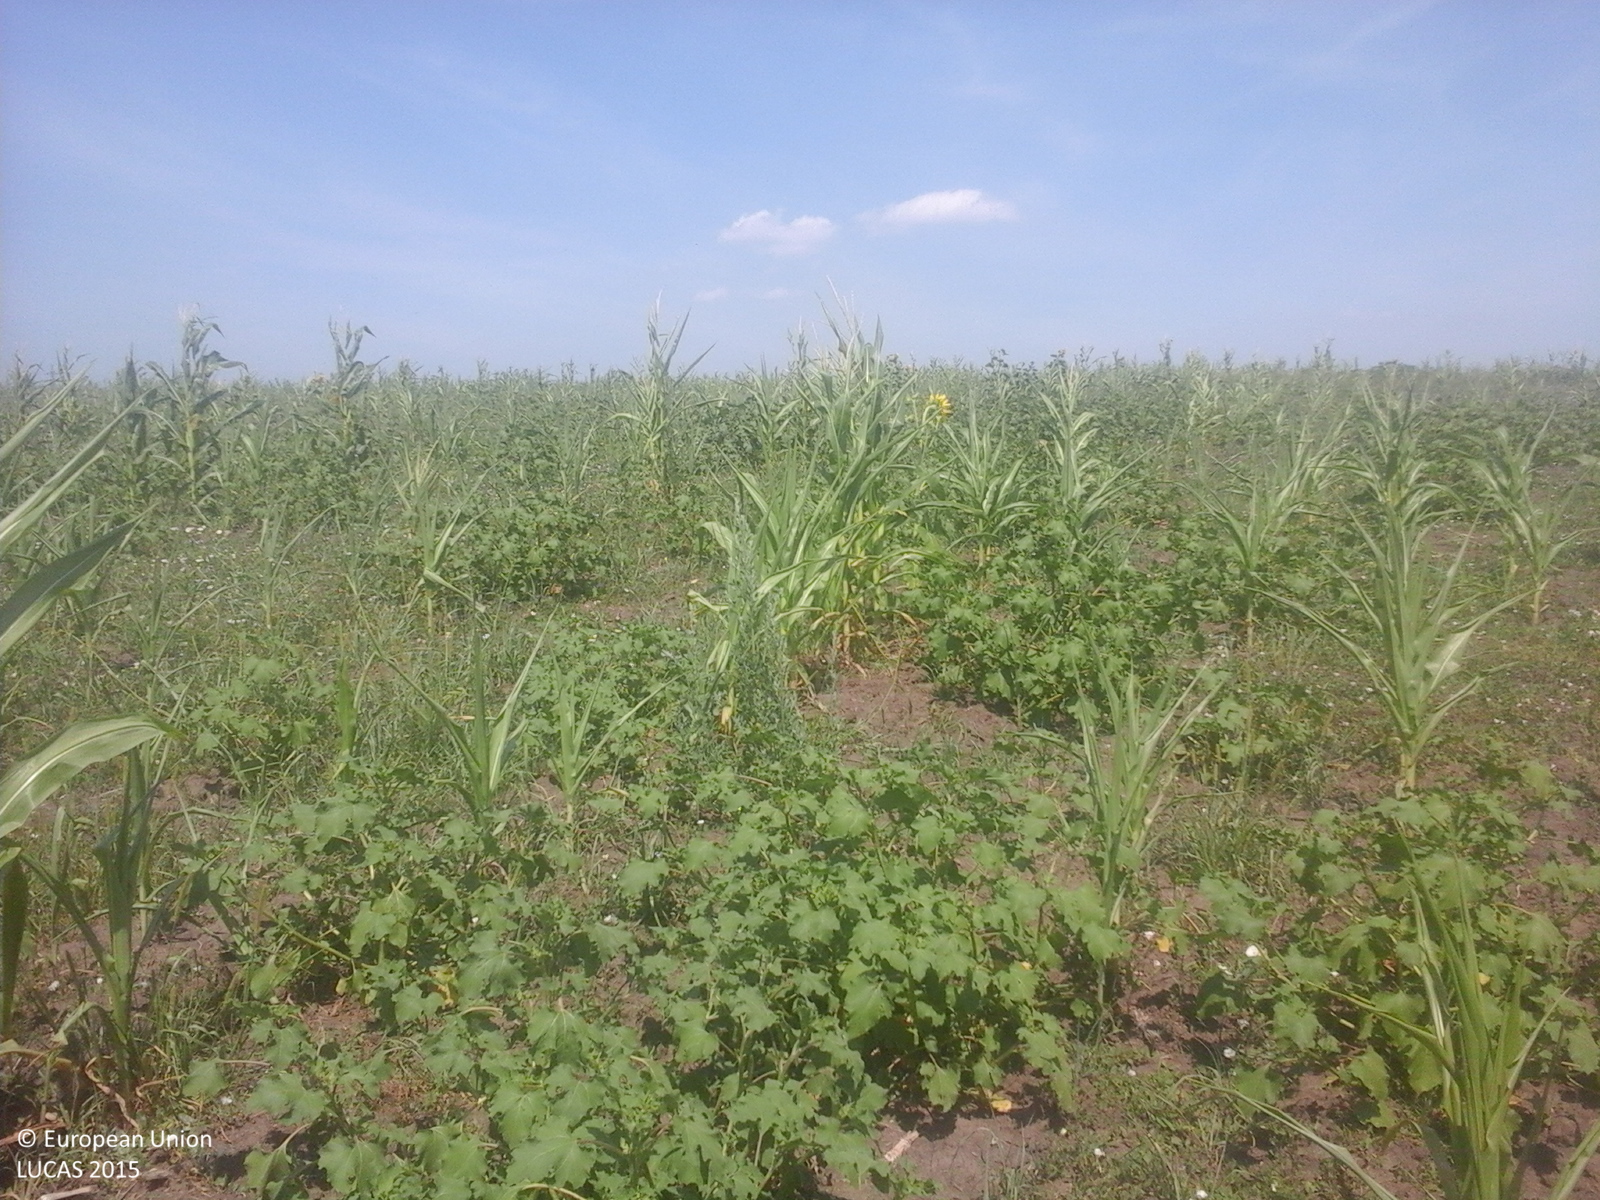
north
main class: Cropland
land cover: Maize
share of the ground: 50 - 75 %
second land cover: Spontaneously vegetated surfaces
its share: 25 - 50 %
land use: Agriculture (excluding fallow land and kitchen gardens)
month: July
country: RO
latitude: 46.6575
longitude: 27.9644
